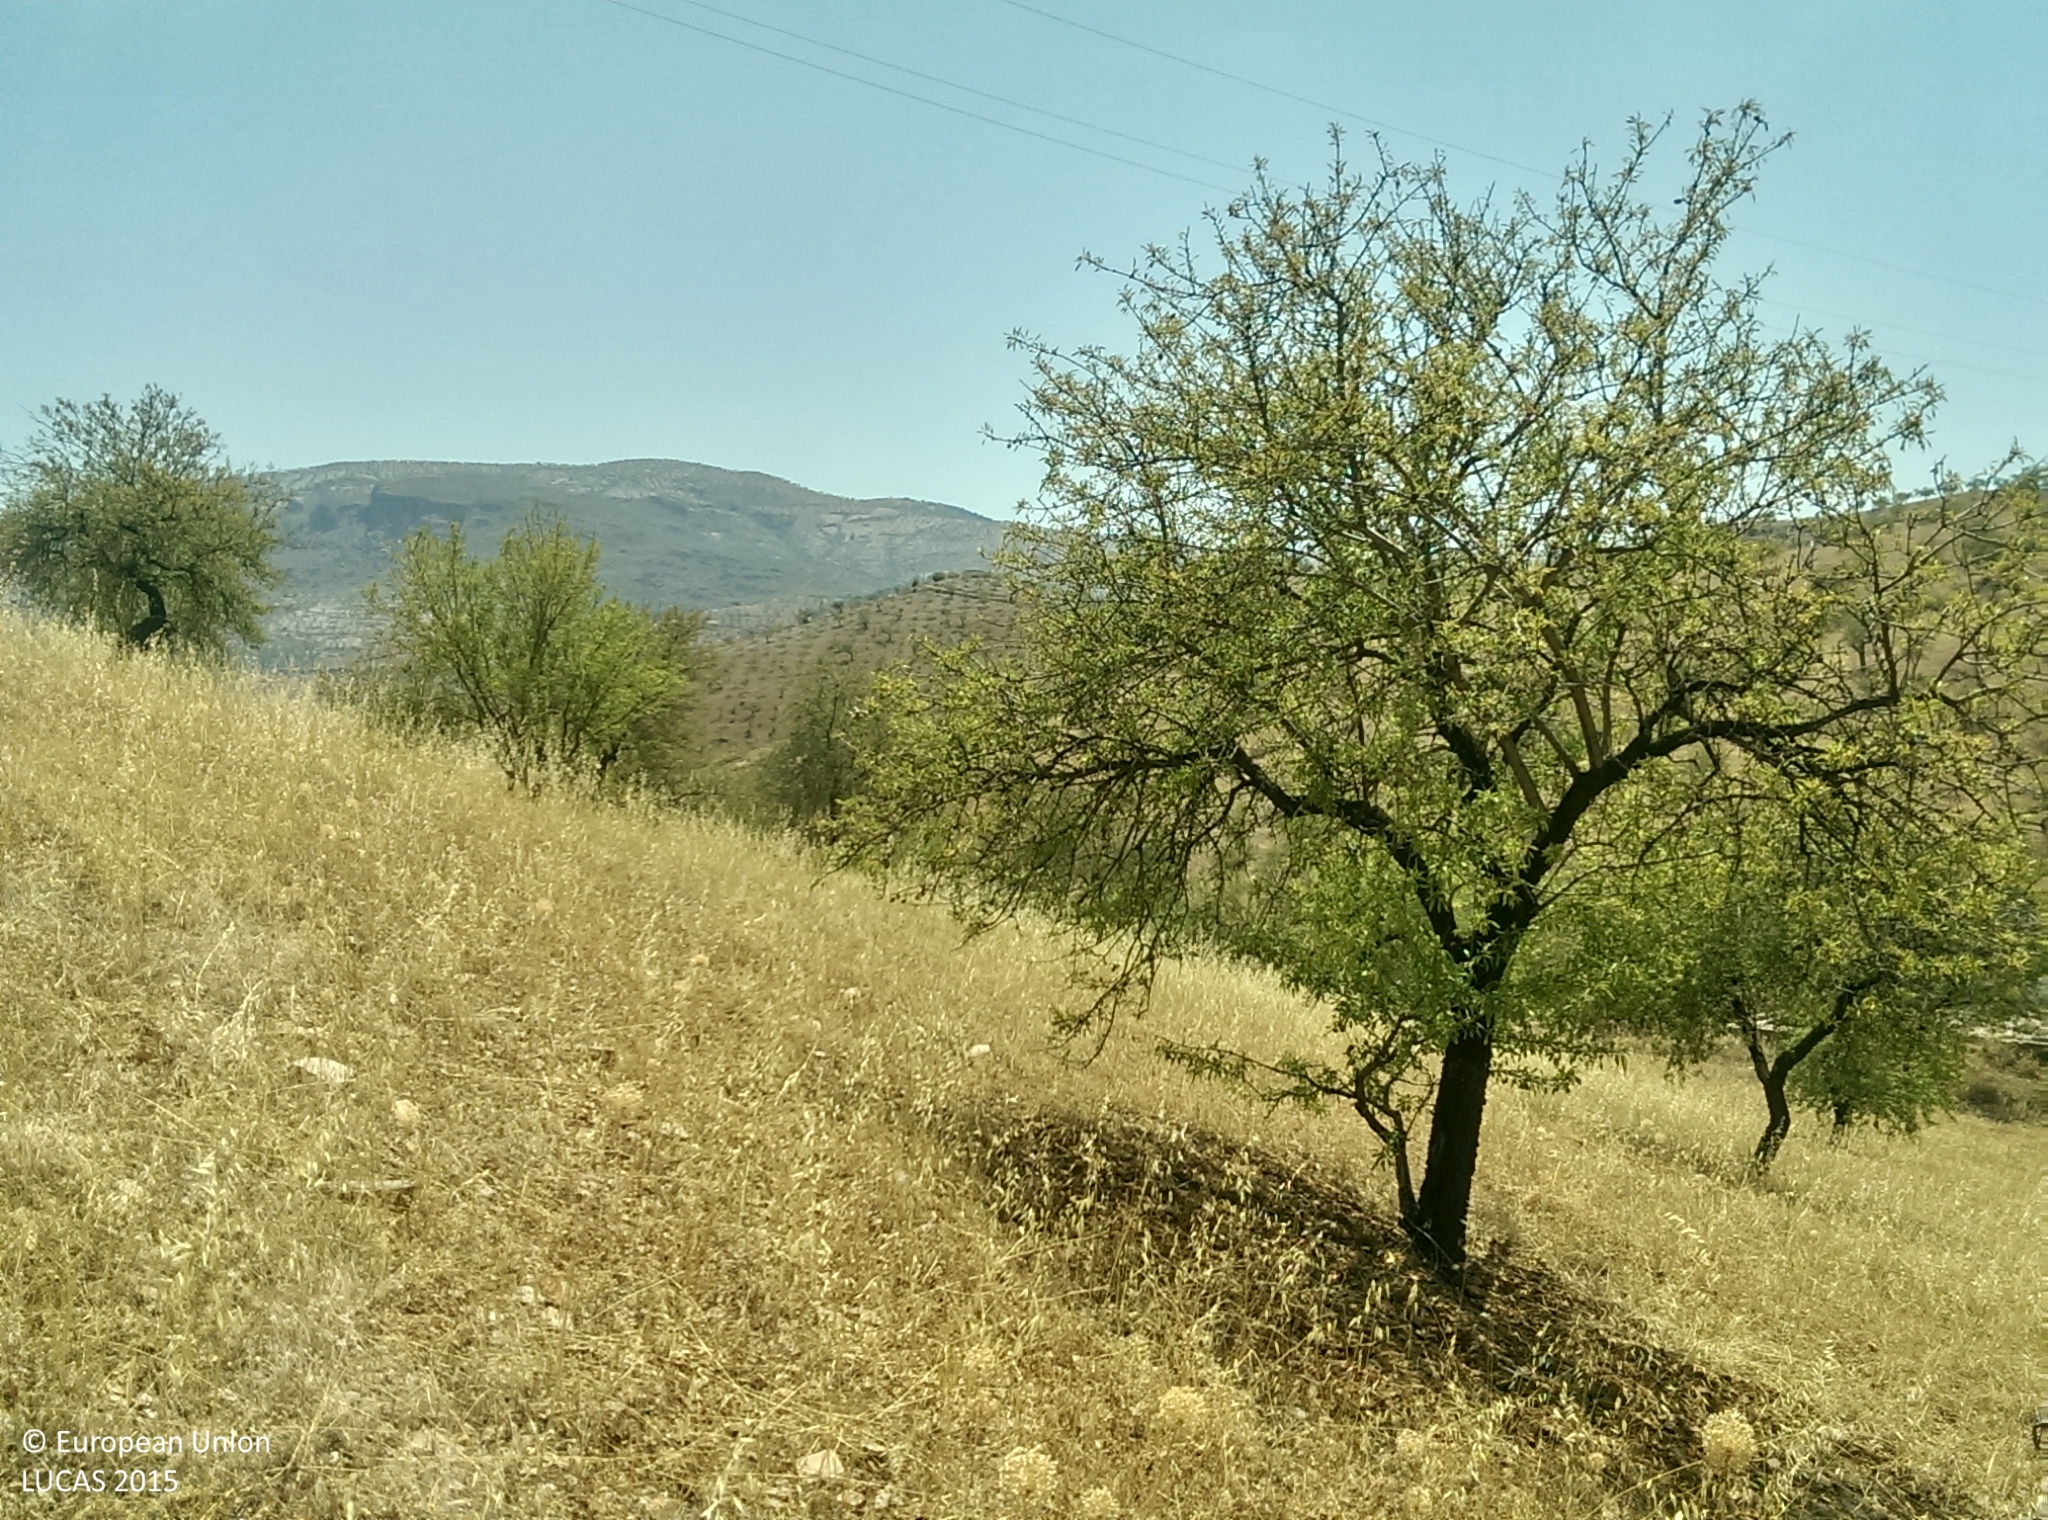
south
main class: Cropland
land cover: Nuts trees
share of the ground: 10 - 25 %
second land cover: Spontaneously vegetated surfaces
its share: 10 - 25 %
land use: Agriculture (excluding fallow land and kitchen gardens)
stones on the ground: 25 - 50 %
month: July
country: ES
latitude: 36.9460
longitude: -3.1081
